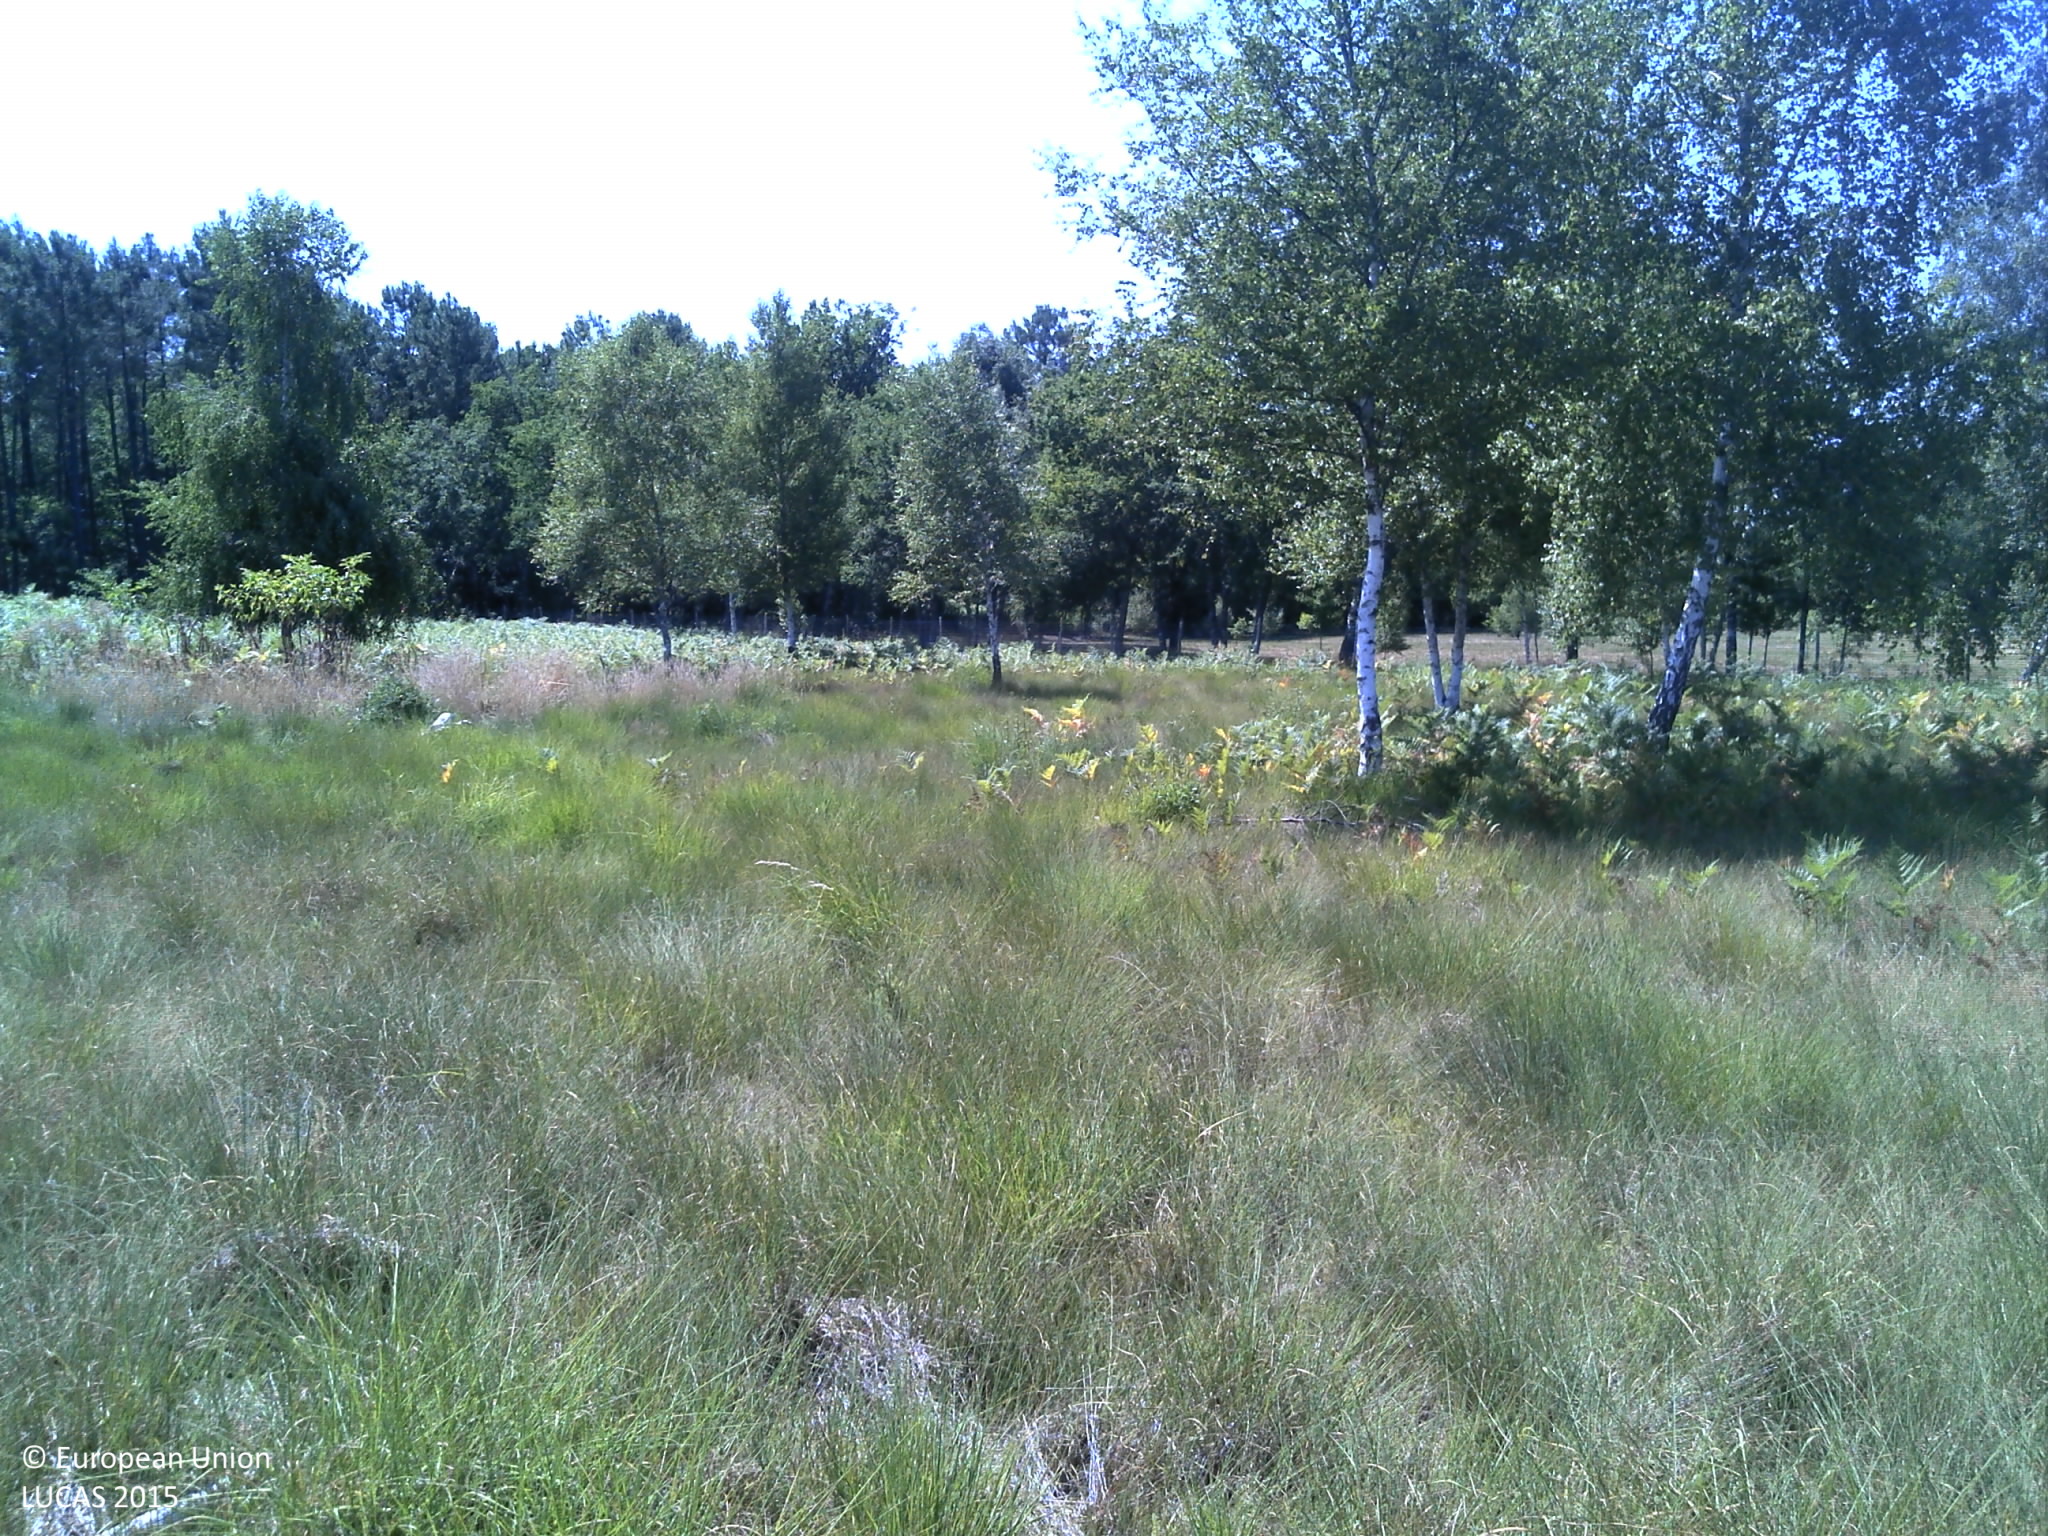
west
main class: Grassland
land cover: Grassland with sparse tree/shrub cover
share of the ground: > 75 %
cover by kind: herbaceous plants 80 %, shrubs 10 %, broadleaved forest trees 5 %, lichens and mosses 5 %
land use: Agriculture (excluding fallow land and kitchen gardens)
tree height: < 5 m
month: July
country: FR
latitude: 44.5662
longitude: -0.6318
